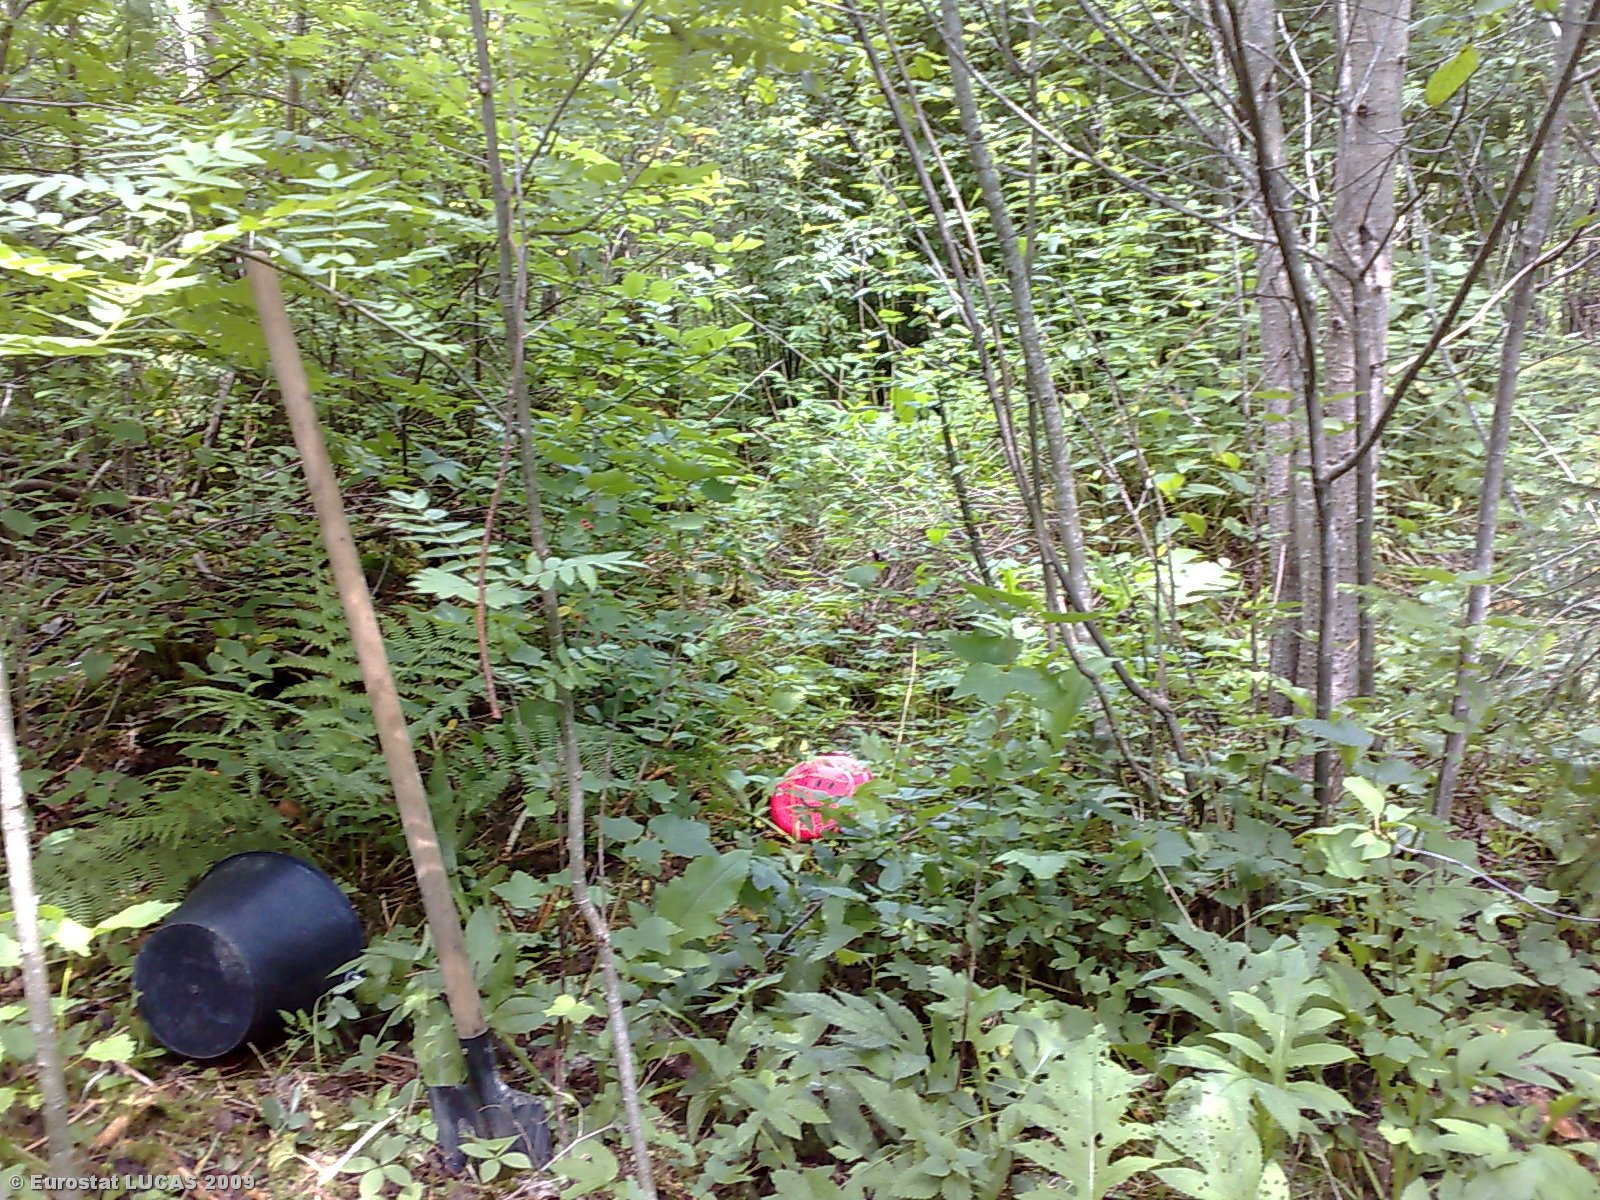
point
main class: Woodland
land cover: Broadleaved woodland
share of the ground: > 75 %
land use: Forestry
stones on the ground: < 10 %
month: July
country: LT
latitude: 55.9883
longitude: 22.9062
